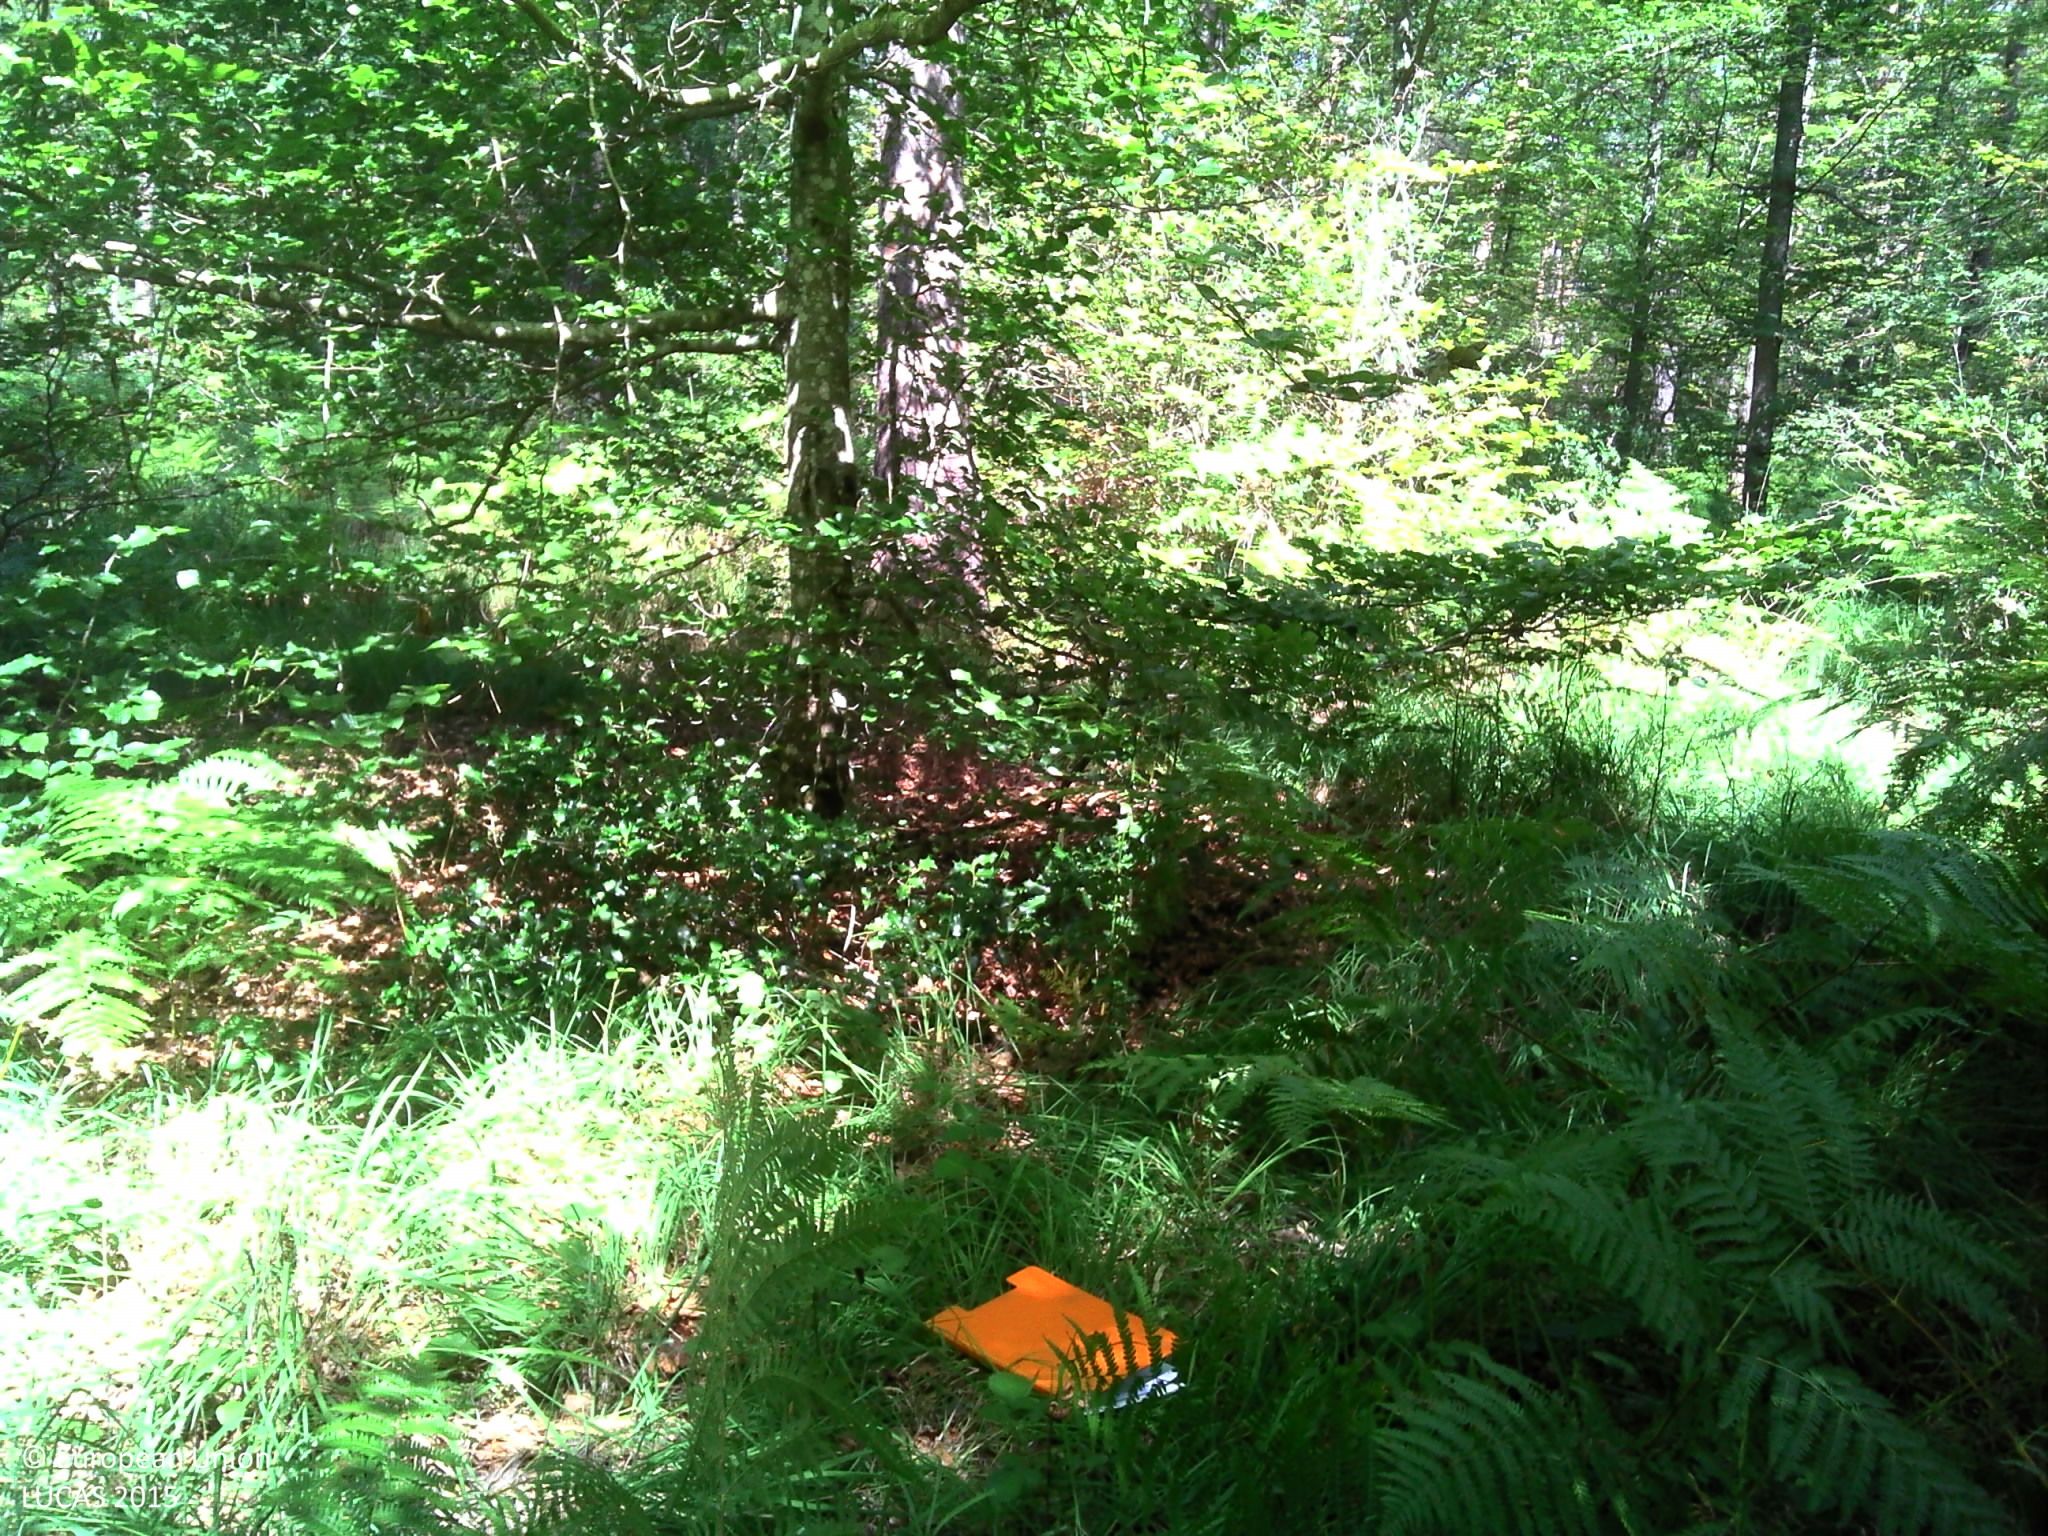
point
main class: Woodland
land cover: Pine dominated mixed woodland
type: mesophytic deciduous forest
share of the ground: > 75 %
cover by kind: broadleaved forest trees 50 %, coniferous forest trees 40 %, herbaceous plants 10 %
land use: Forestry
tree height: > 5 m
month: August
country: FR
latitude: 47.2688
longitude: 2.0732
